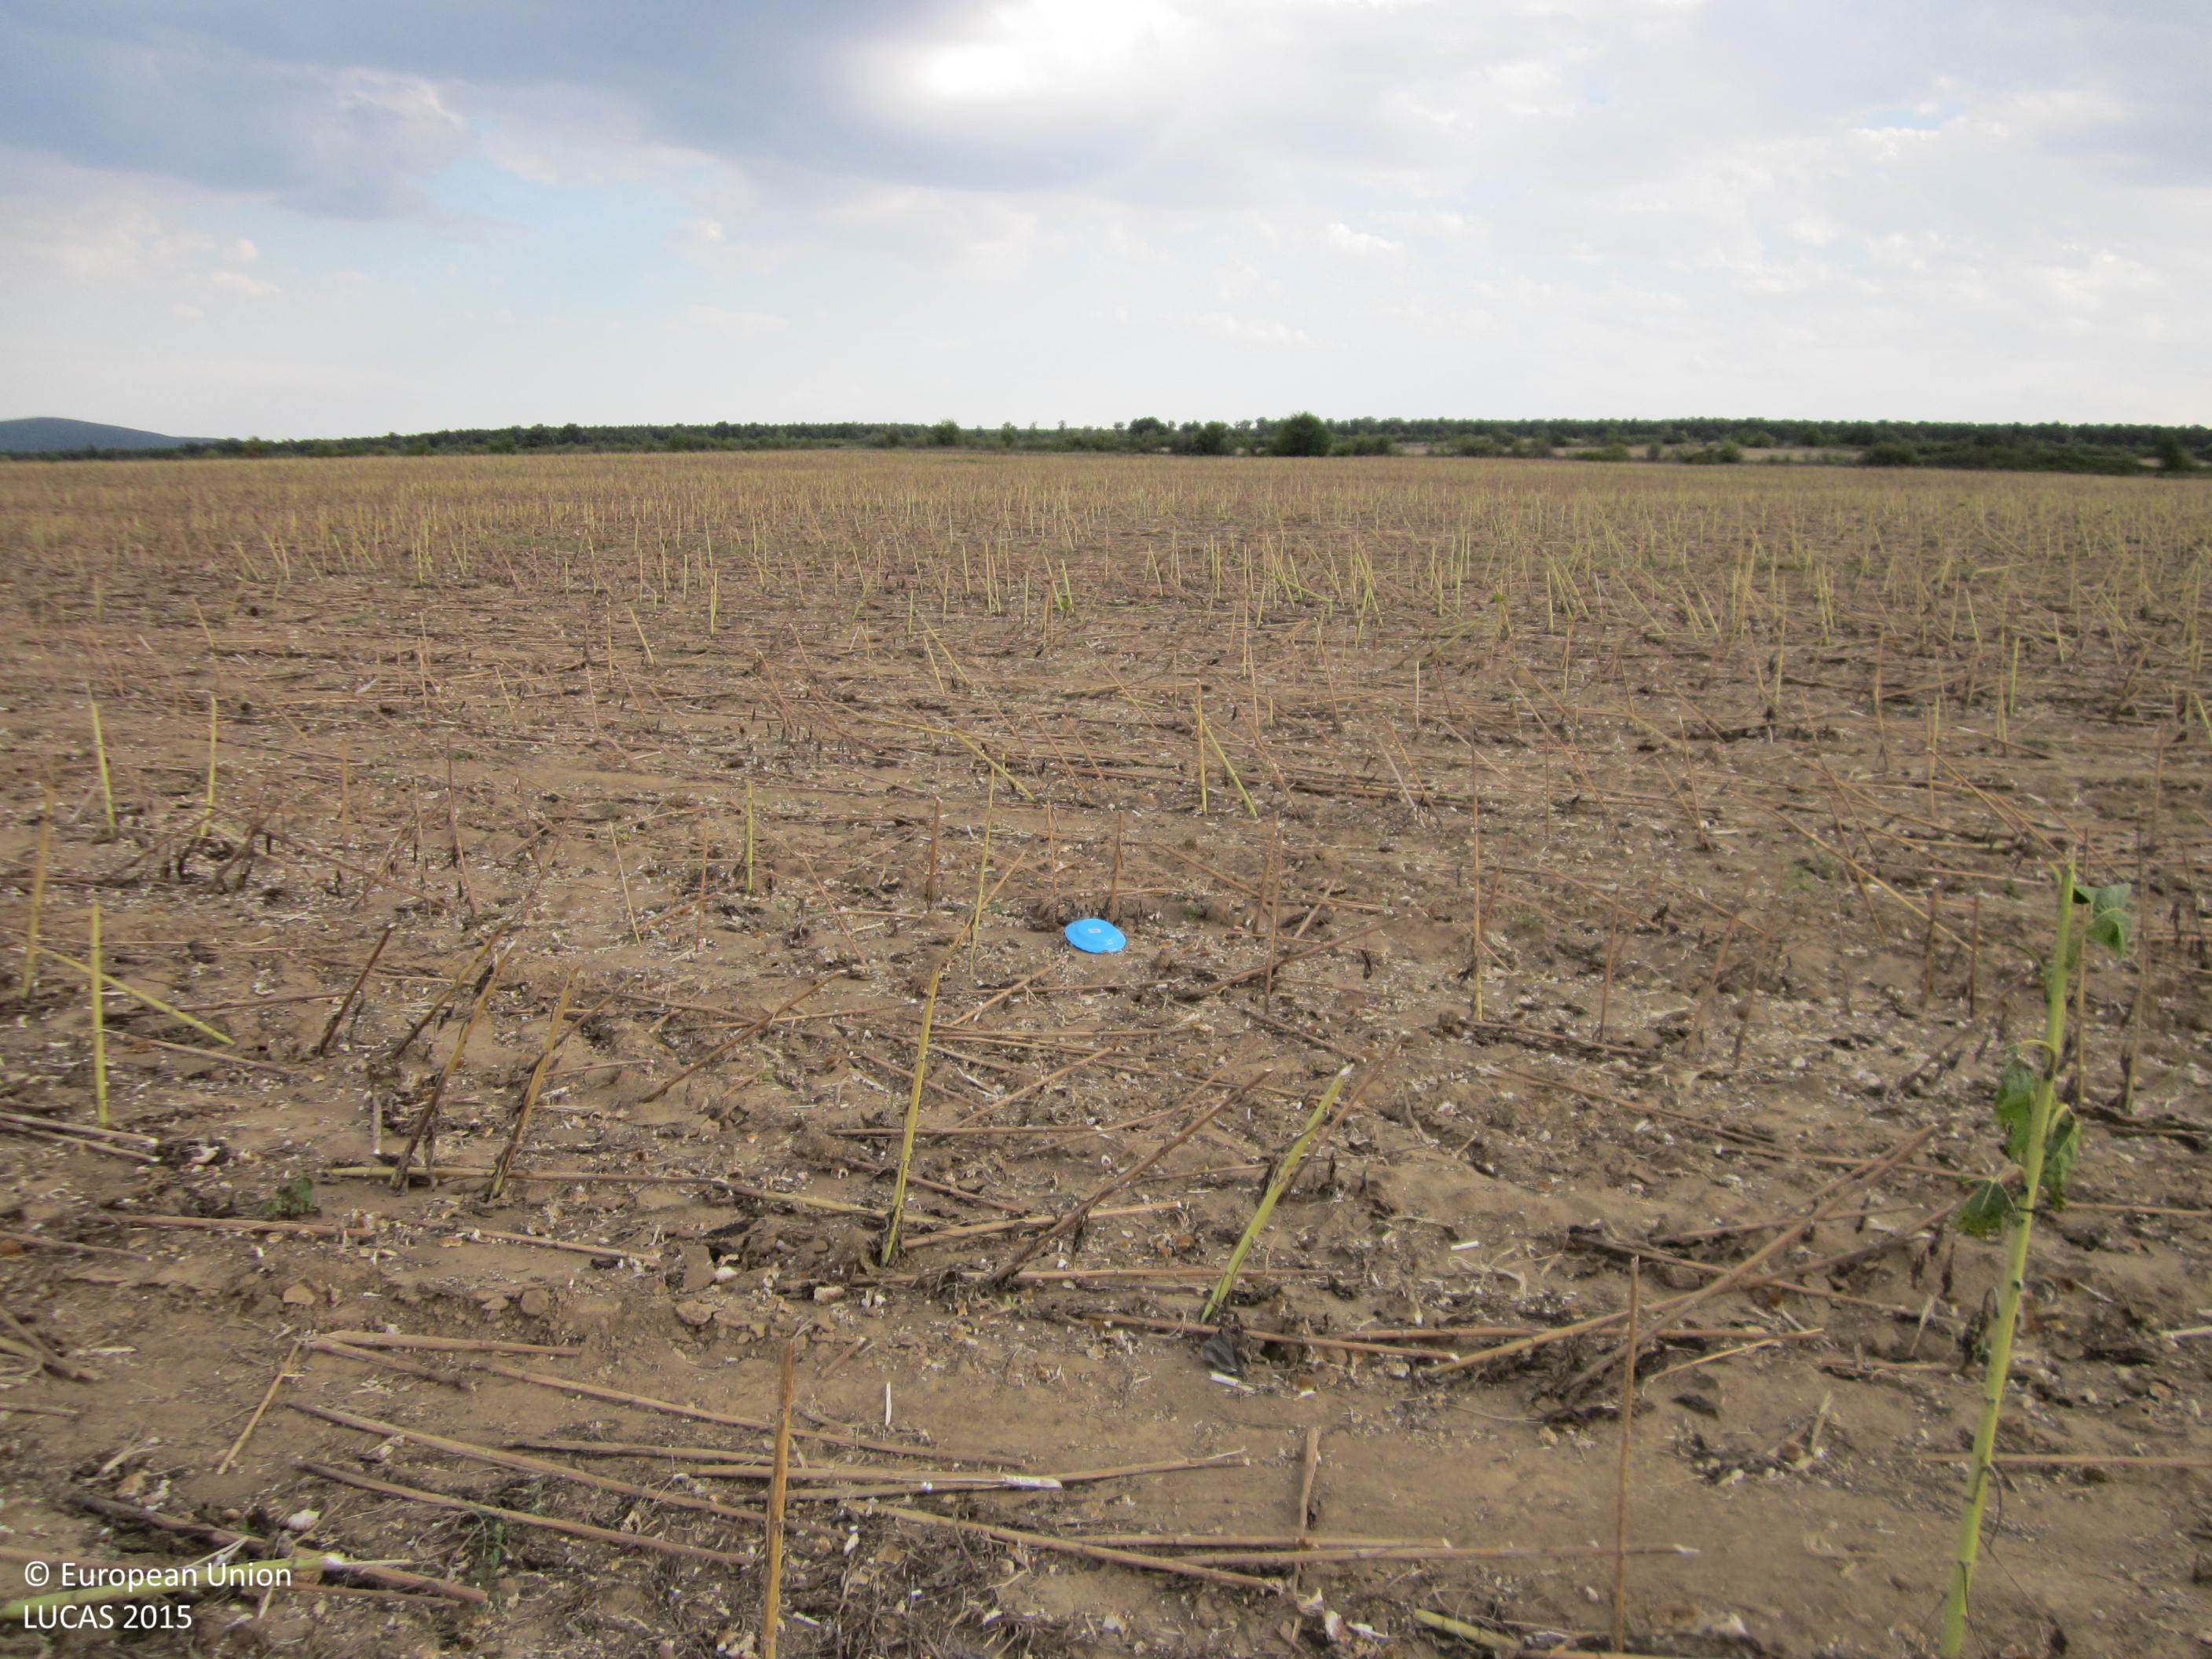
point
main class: Cropland
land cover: Sunflower
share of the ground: 25 - 50 %
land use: Agriculture (excluding fallow land and kitchen gardens)
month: September
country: BG
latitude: 42.7888
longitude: 27.3173
